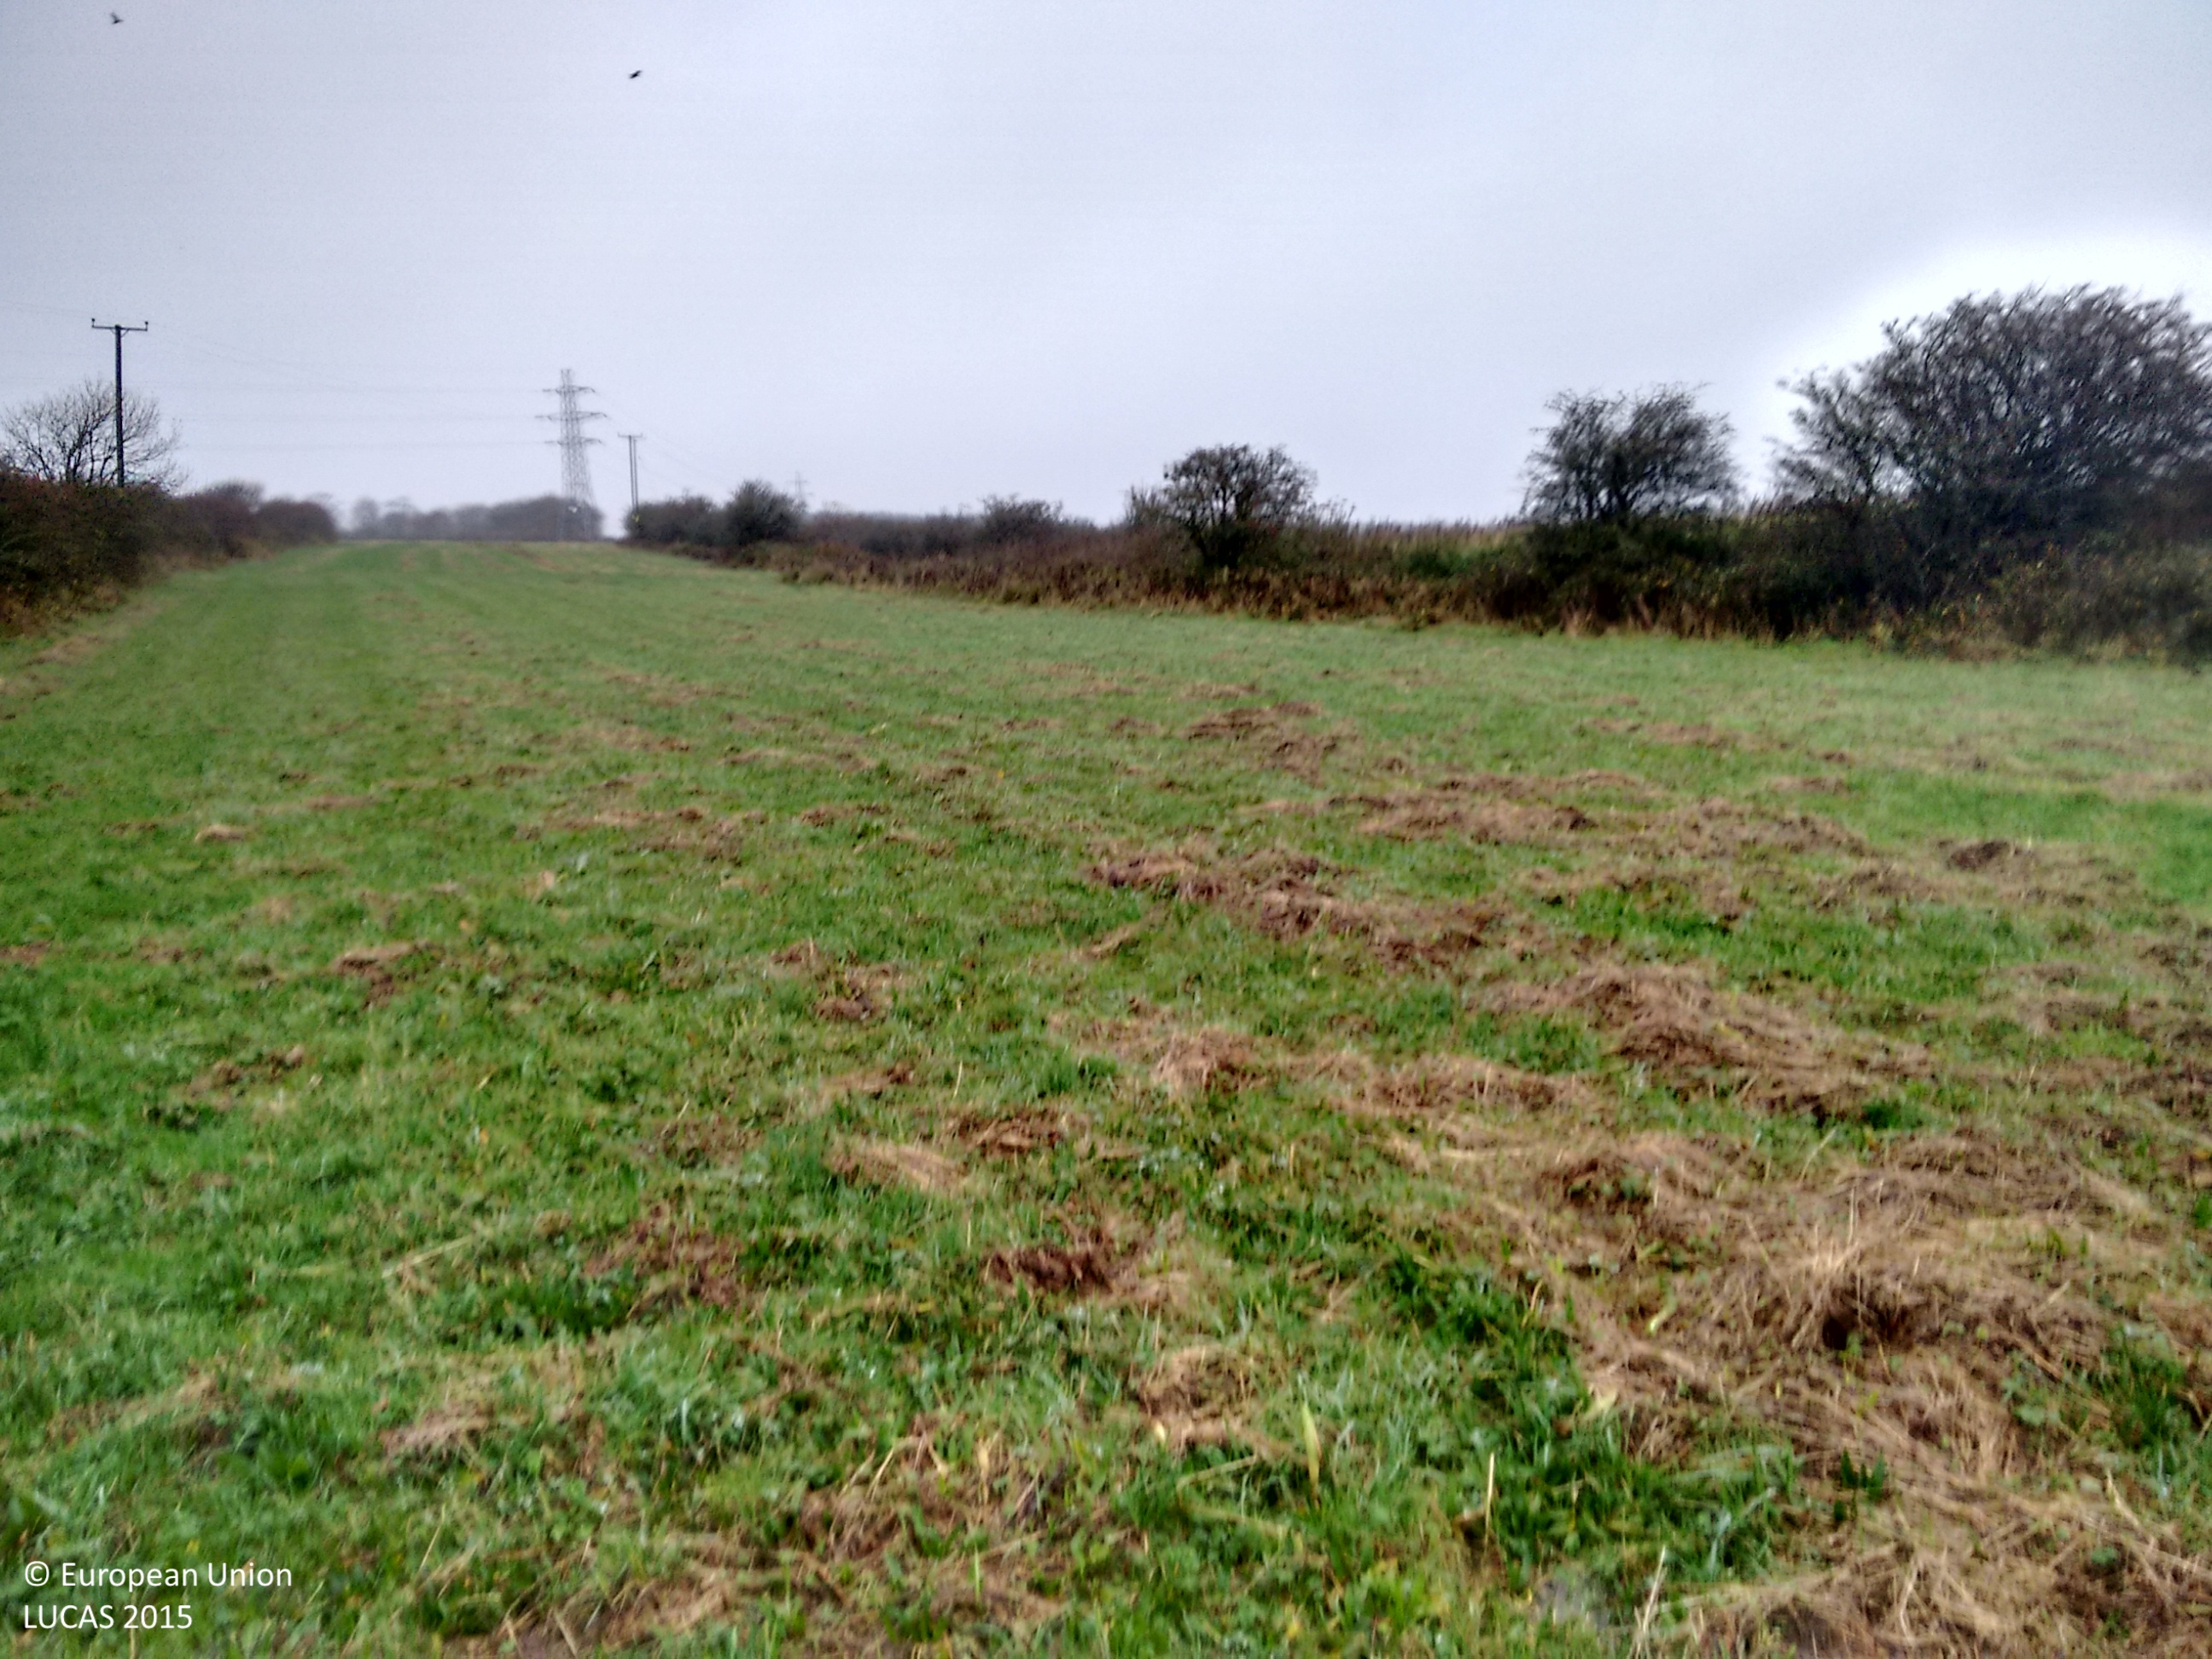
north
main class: Grassland
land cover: Grassland without tree/shrub cover
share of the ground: > 75 %
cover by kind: herbaceous plants 100 %
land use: Agriculture (excluding fallow land and kitchen gardens)
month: November
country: GB
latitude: 54.5342
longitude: -3.5434
